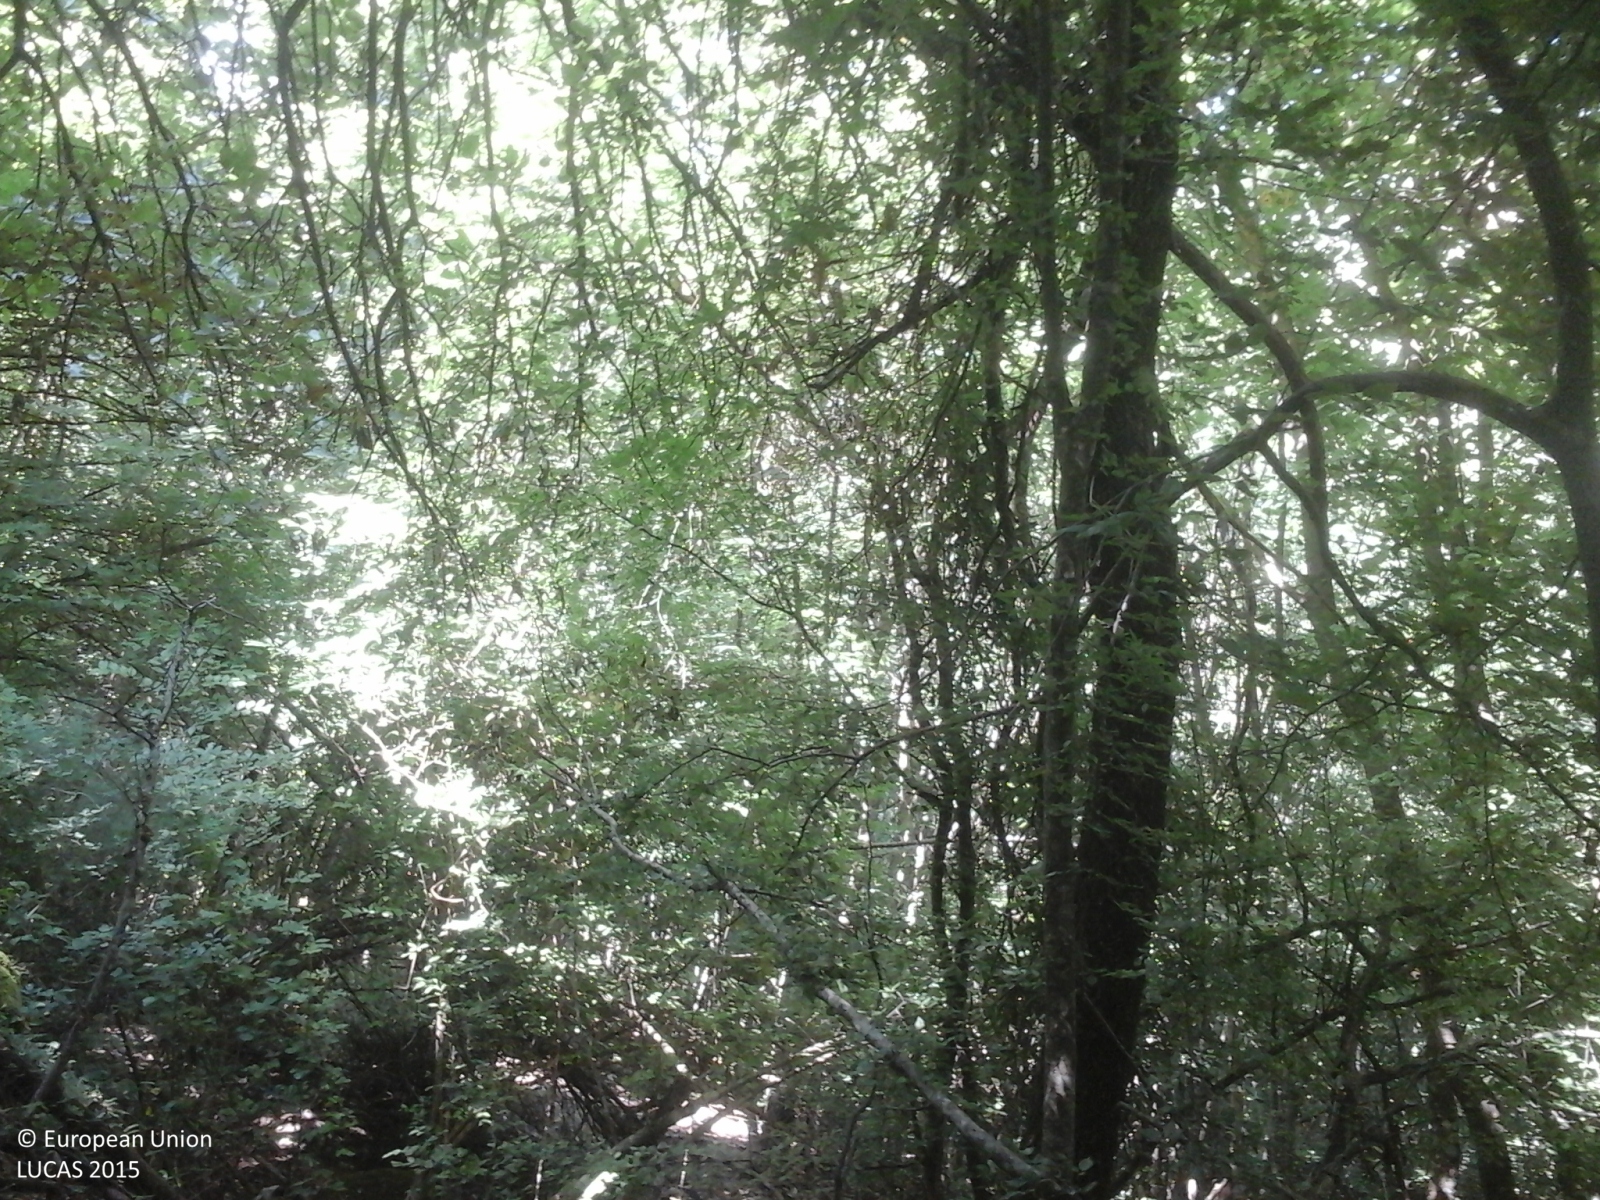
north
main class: Woodland
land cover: Broadleaved woodland
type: thermophilous deciduous forest
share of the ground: > 75 %
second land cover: Grassland without tree/shrub cover
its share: > 75 %
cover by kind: broadleaved forest trees 95 %, herbaceous plants 5 %
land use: Forestry
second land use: Agriculture (excluding fallow land and kitchen gardens)
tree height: > 5 m
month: June
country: IT
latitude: 41.5543
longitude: 13.2127
